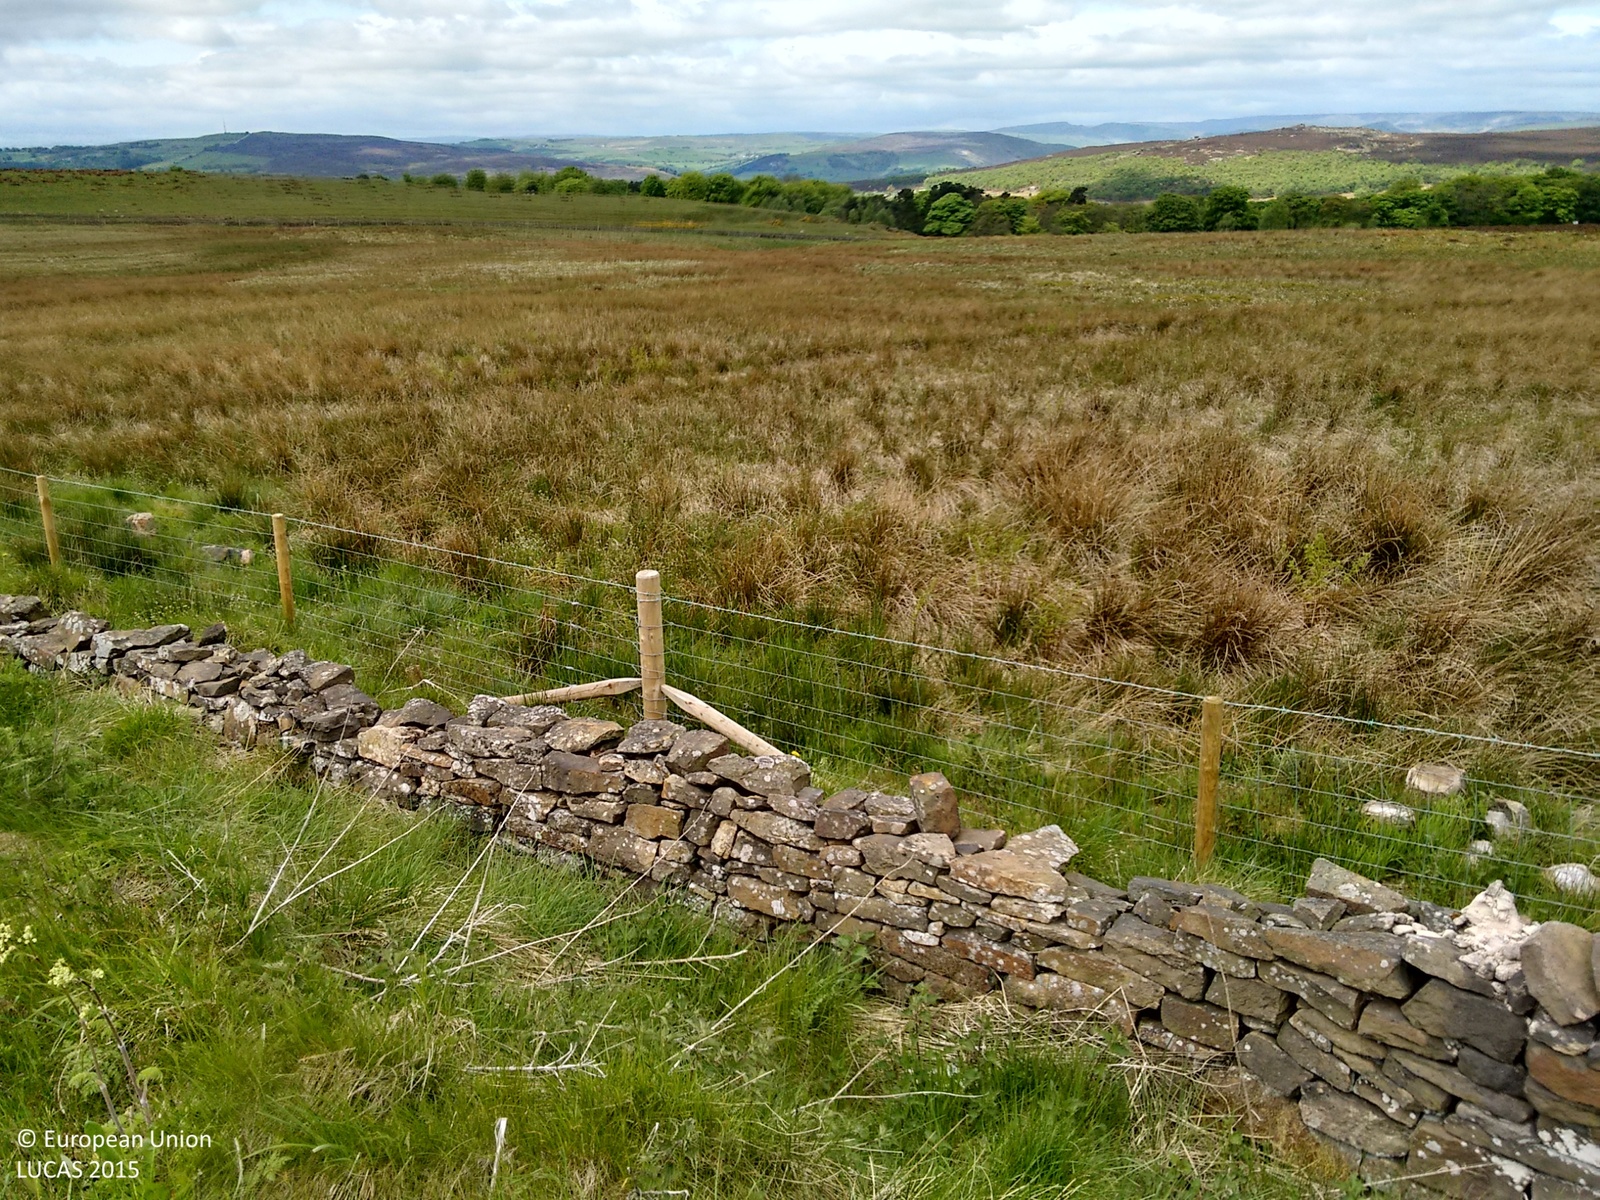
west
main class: Grassland
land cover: Grassland without tree/shrub cover
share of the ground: > 75 %
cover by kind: herbaceous plants 100 %
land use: Agriculture (excluding fallow land and kitchen gardens)
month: May
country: GB
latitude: 53.3152
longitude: -1.5945
